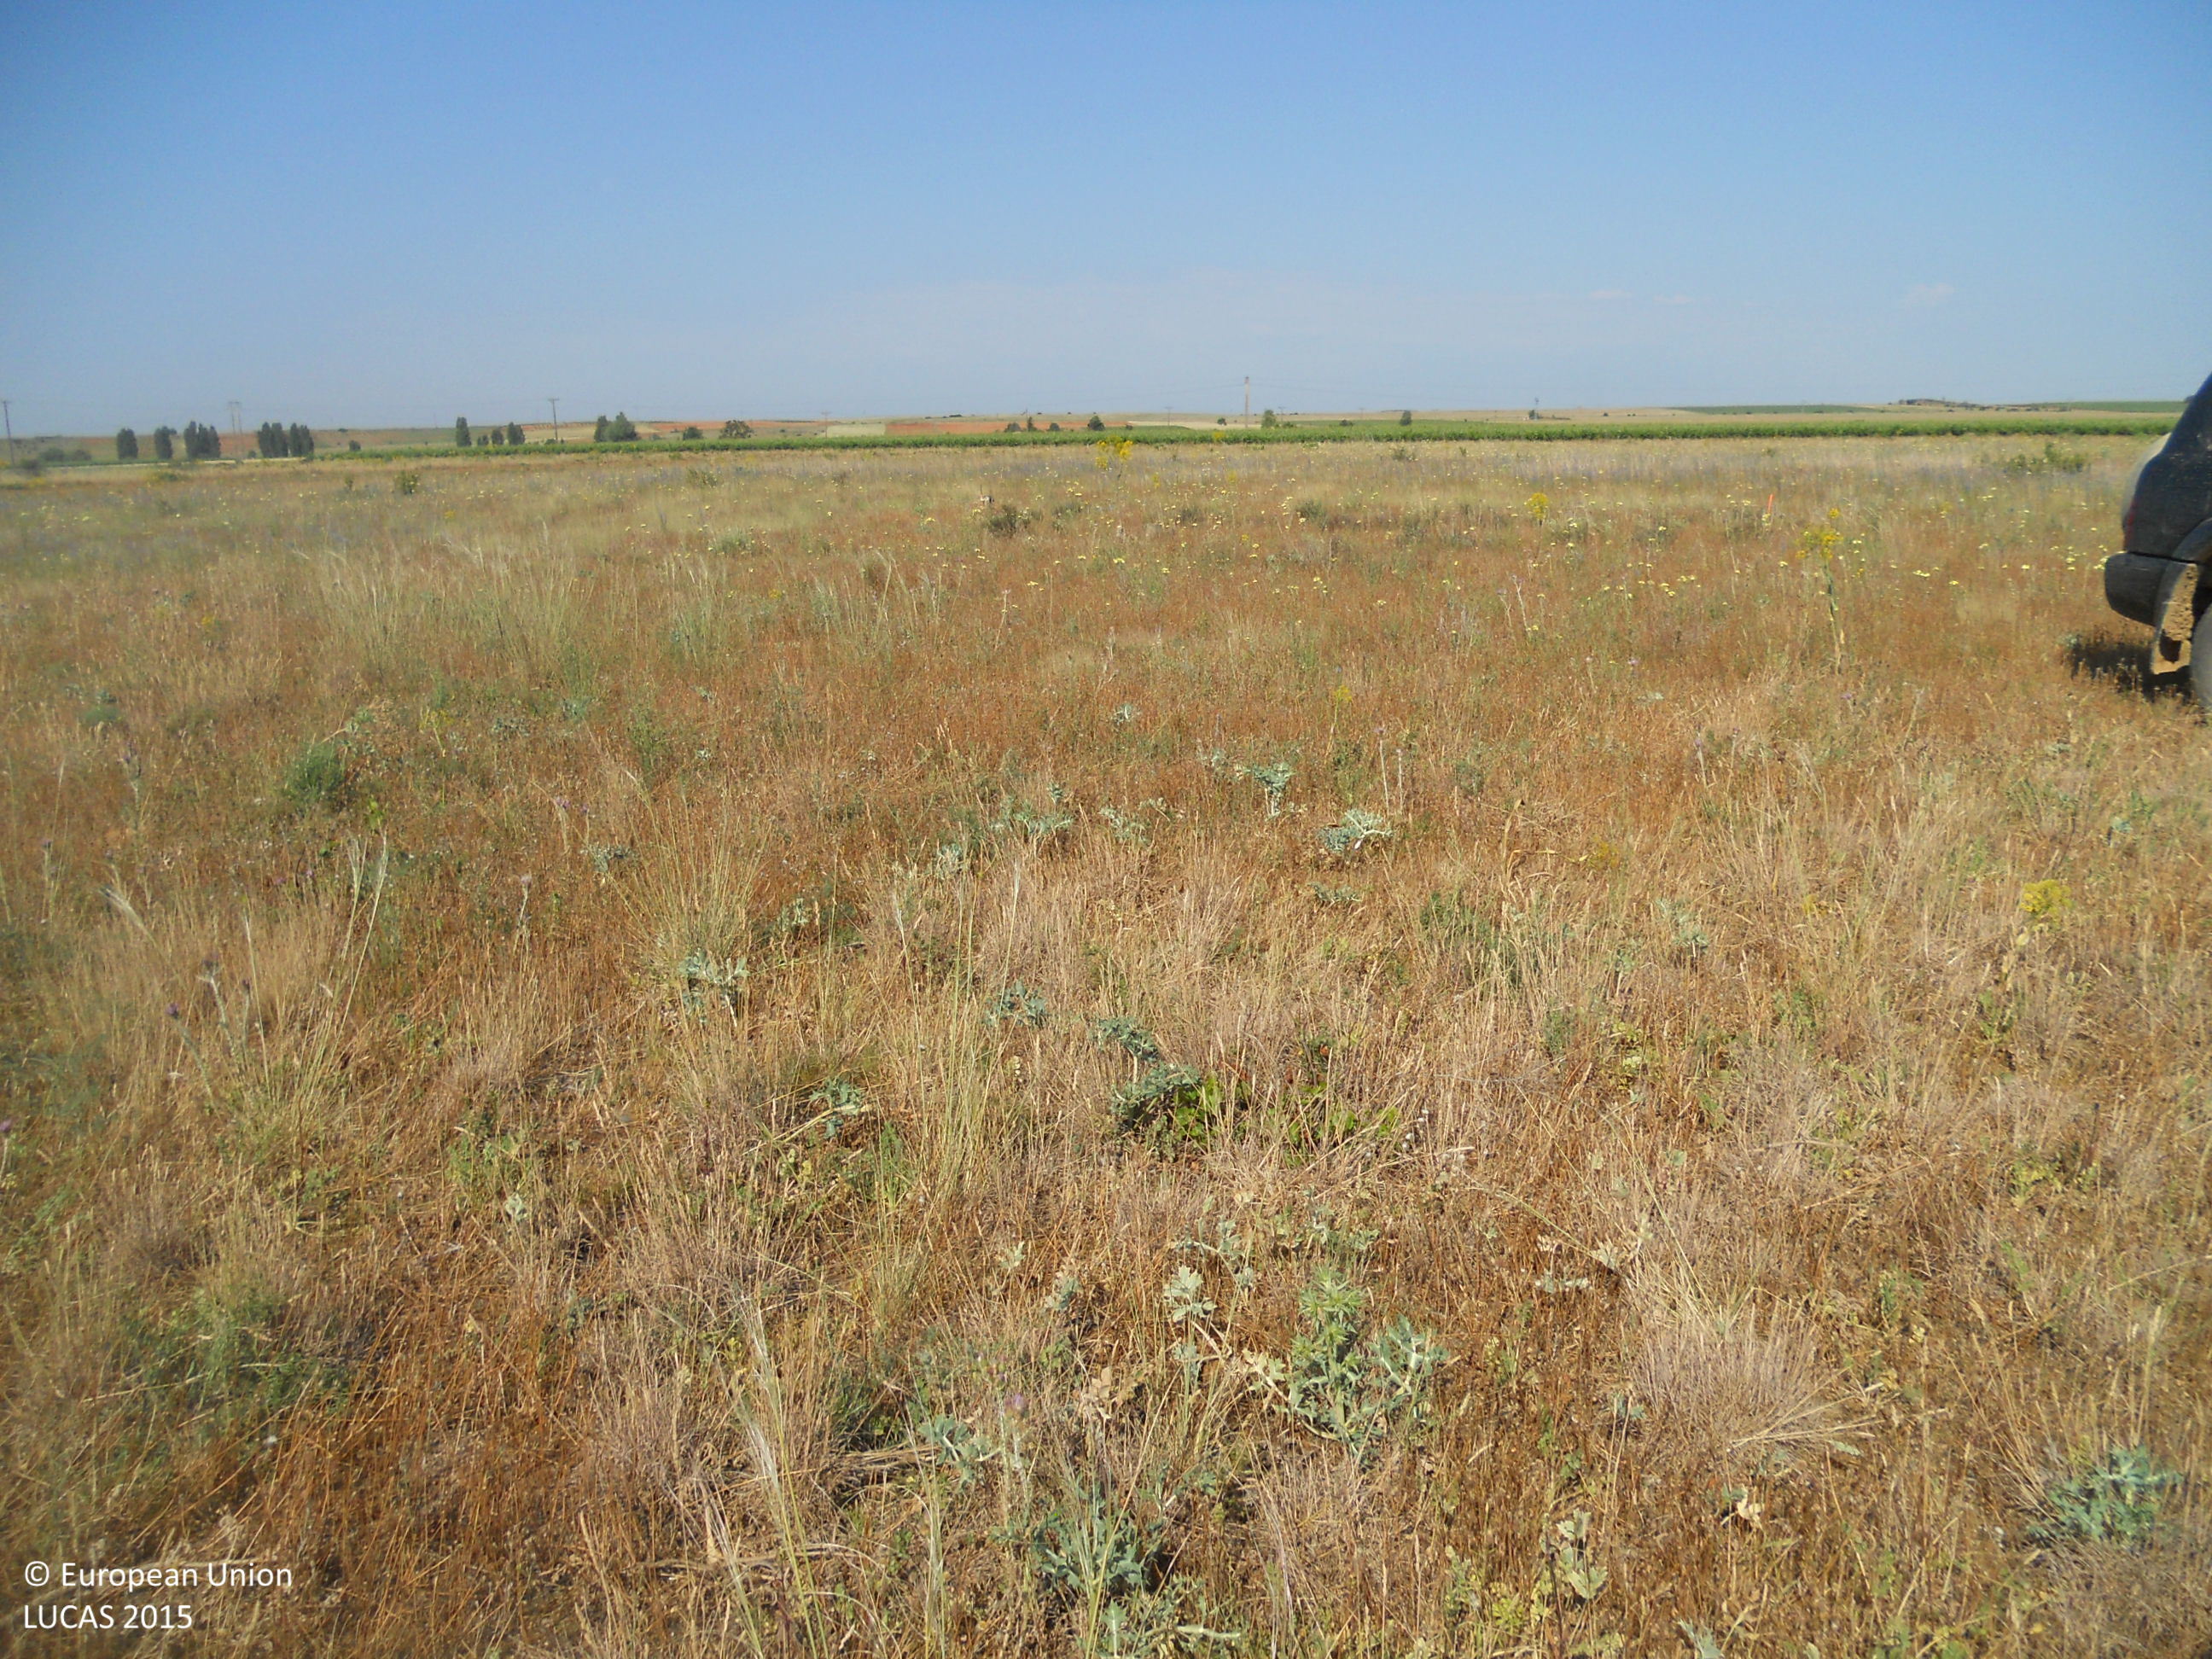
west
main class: Grassland
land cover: Grassland without tree/shrub cover
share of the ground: > 75 %
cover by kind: herbaceous plants 95 %, shrubs 5 %
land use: Semi-natural and natural areas not in use
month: June
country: ES
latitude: 42.4152
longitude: -5.5644
